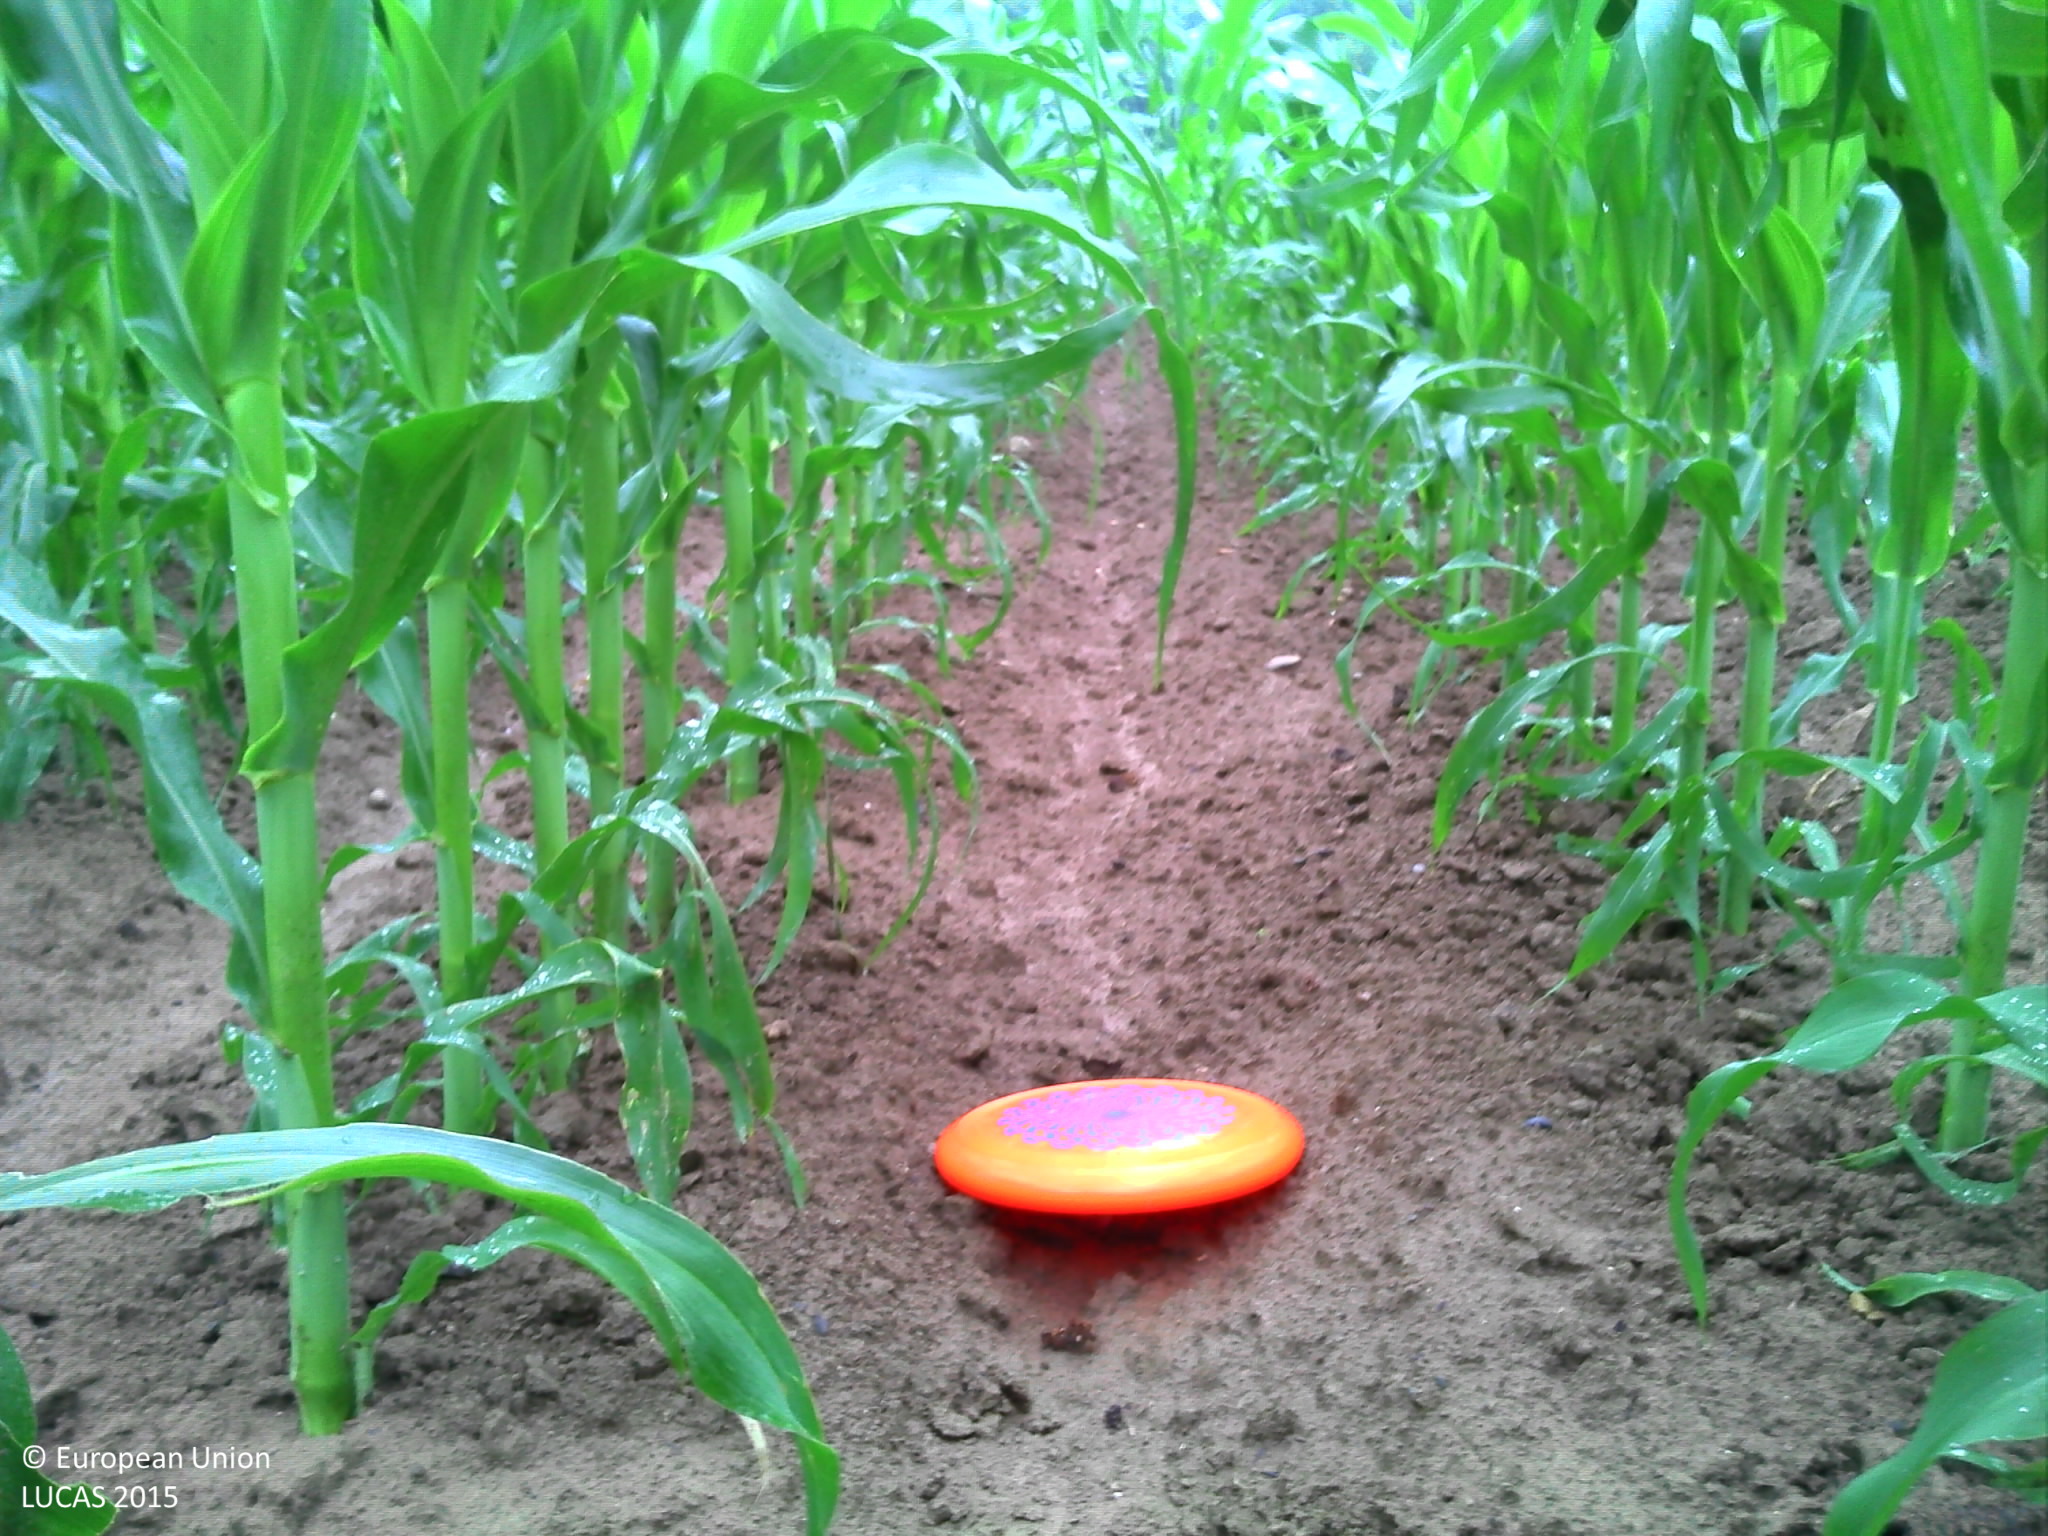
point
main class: Cropland
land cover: Maize
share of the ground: > 75 %
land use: Agriculture (excluding fallow land and kitchen gardens)
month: June
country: FR
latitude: 47.7062
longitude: 7.3760
